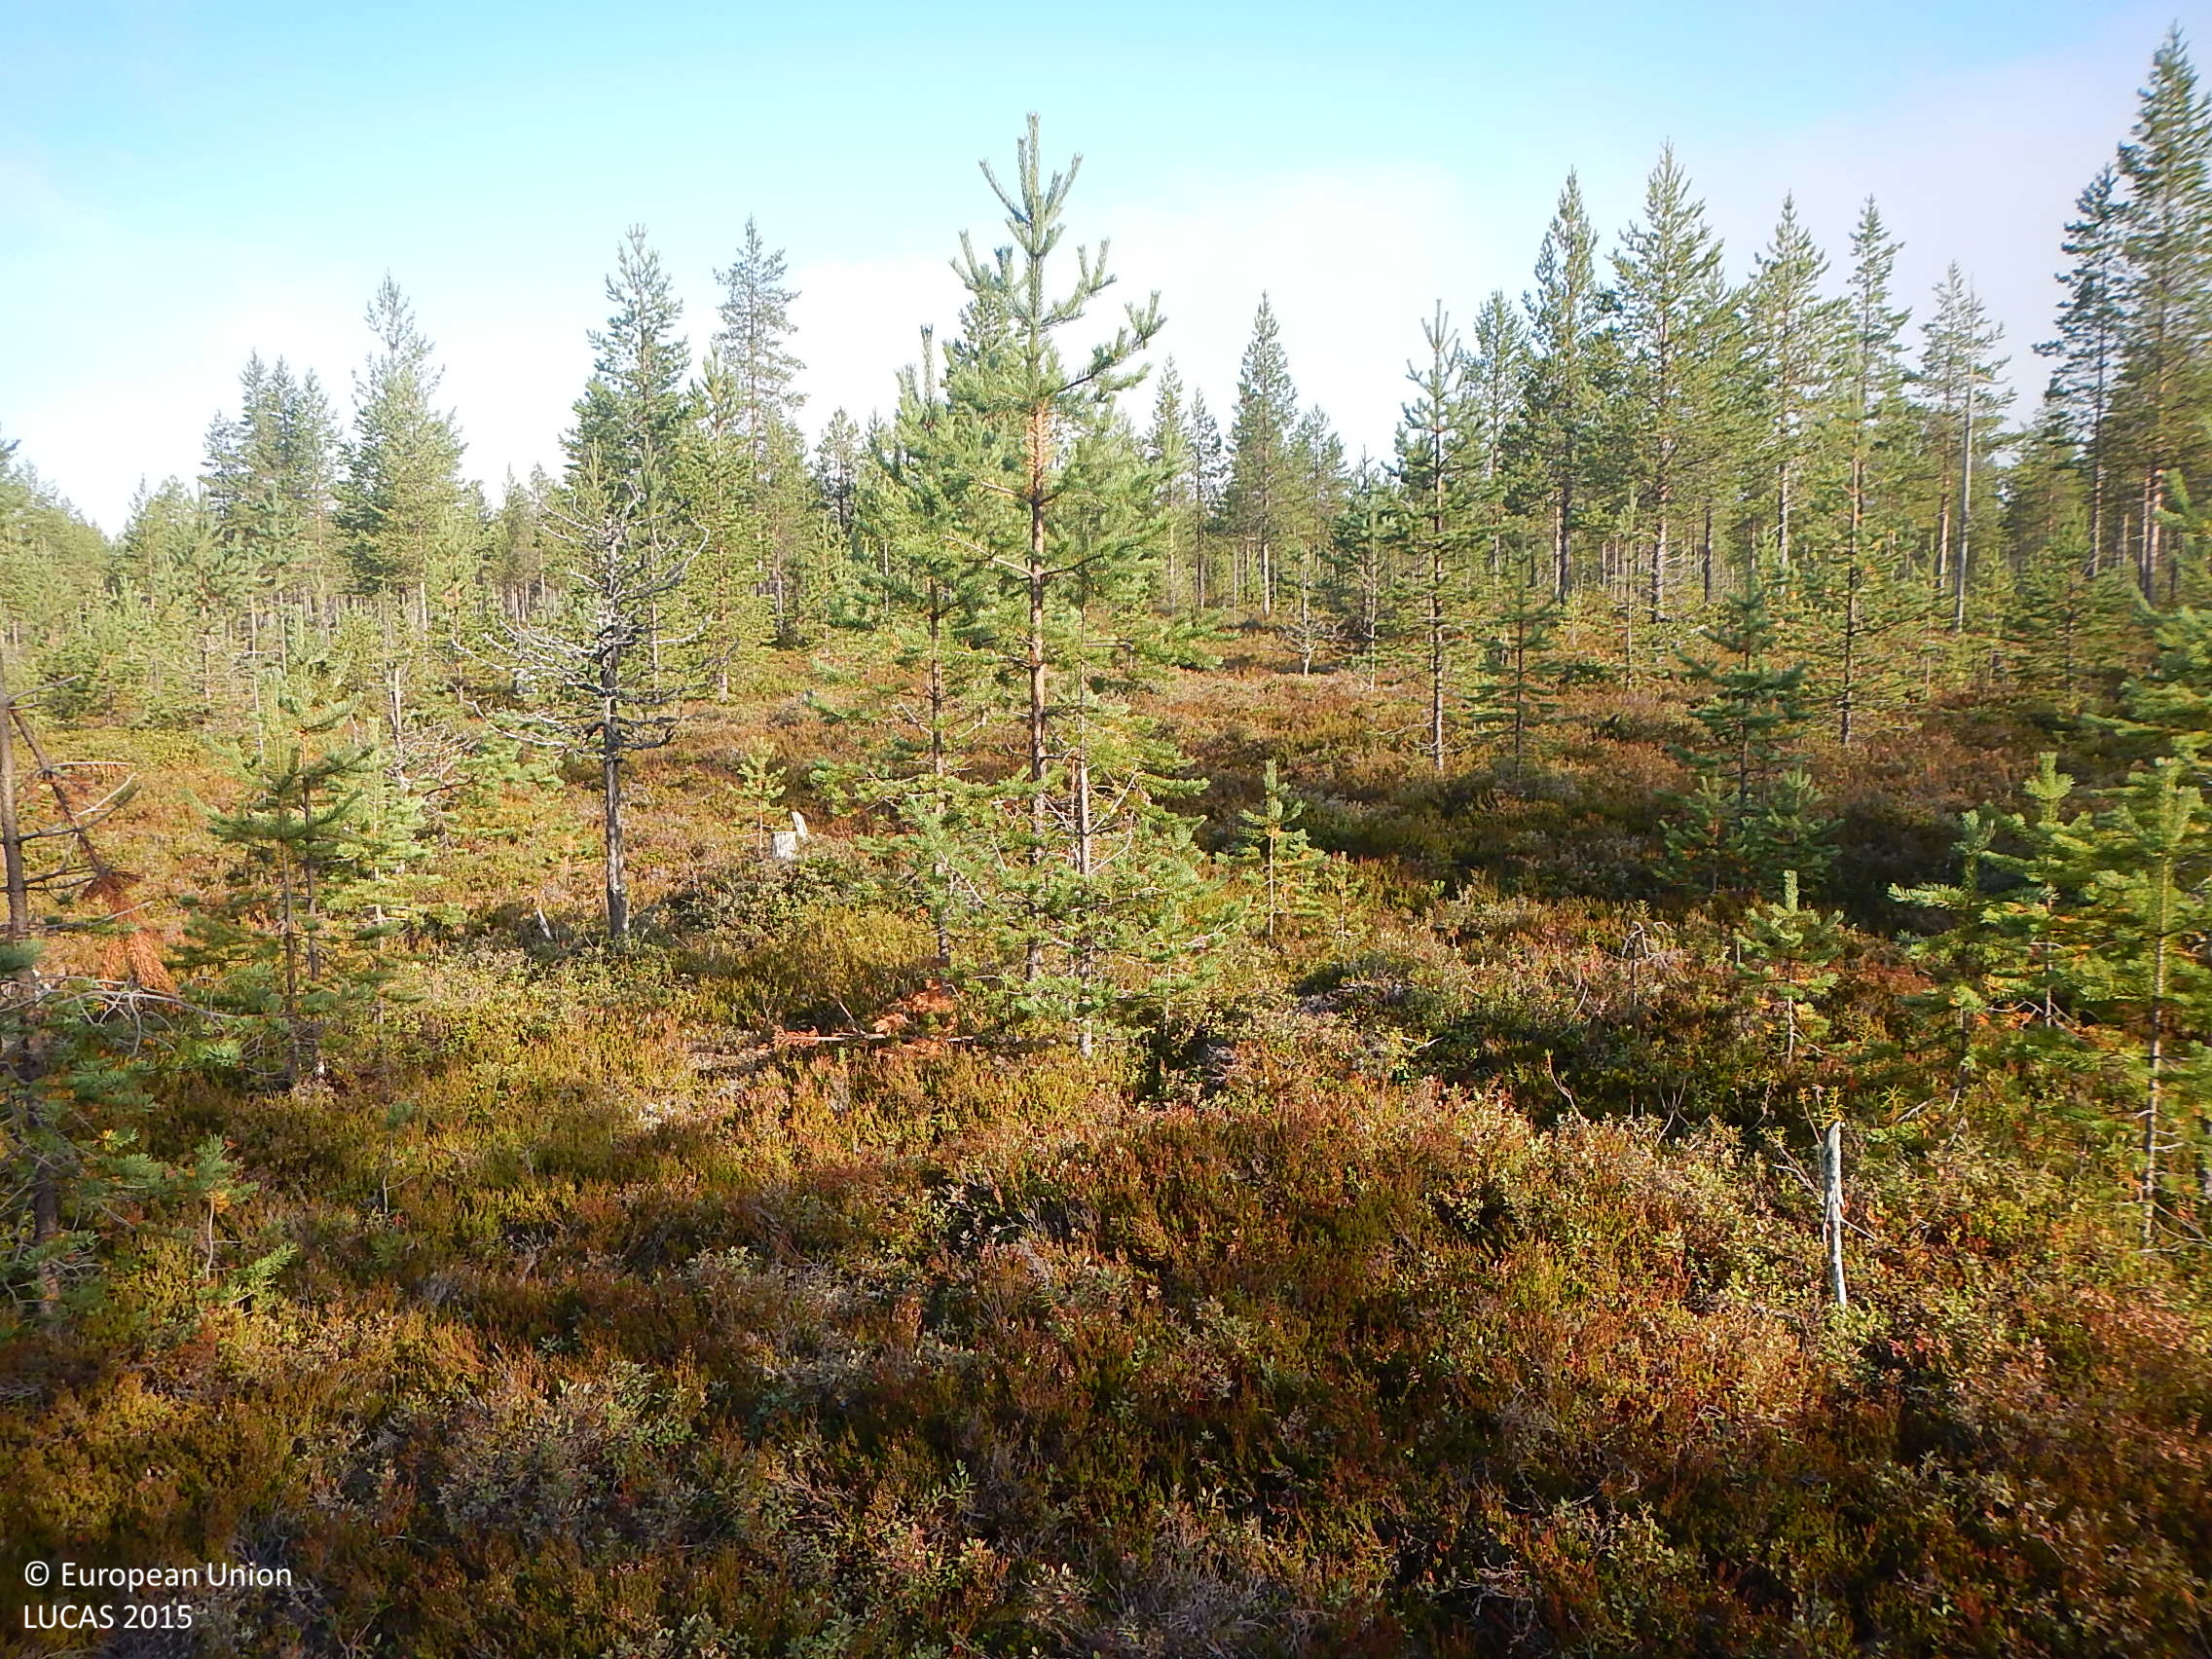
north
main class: Woodland
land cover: Pine dominated coniferous woodland
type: boreal forest
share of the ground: 10 - 25 %
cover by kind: shrubs 80 %, coniferous forest trees 20 %
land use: Forestry
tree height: < 5 m
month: August
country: FI
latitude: 65.4626
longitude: 26.9687
